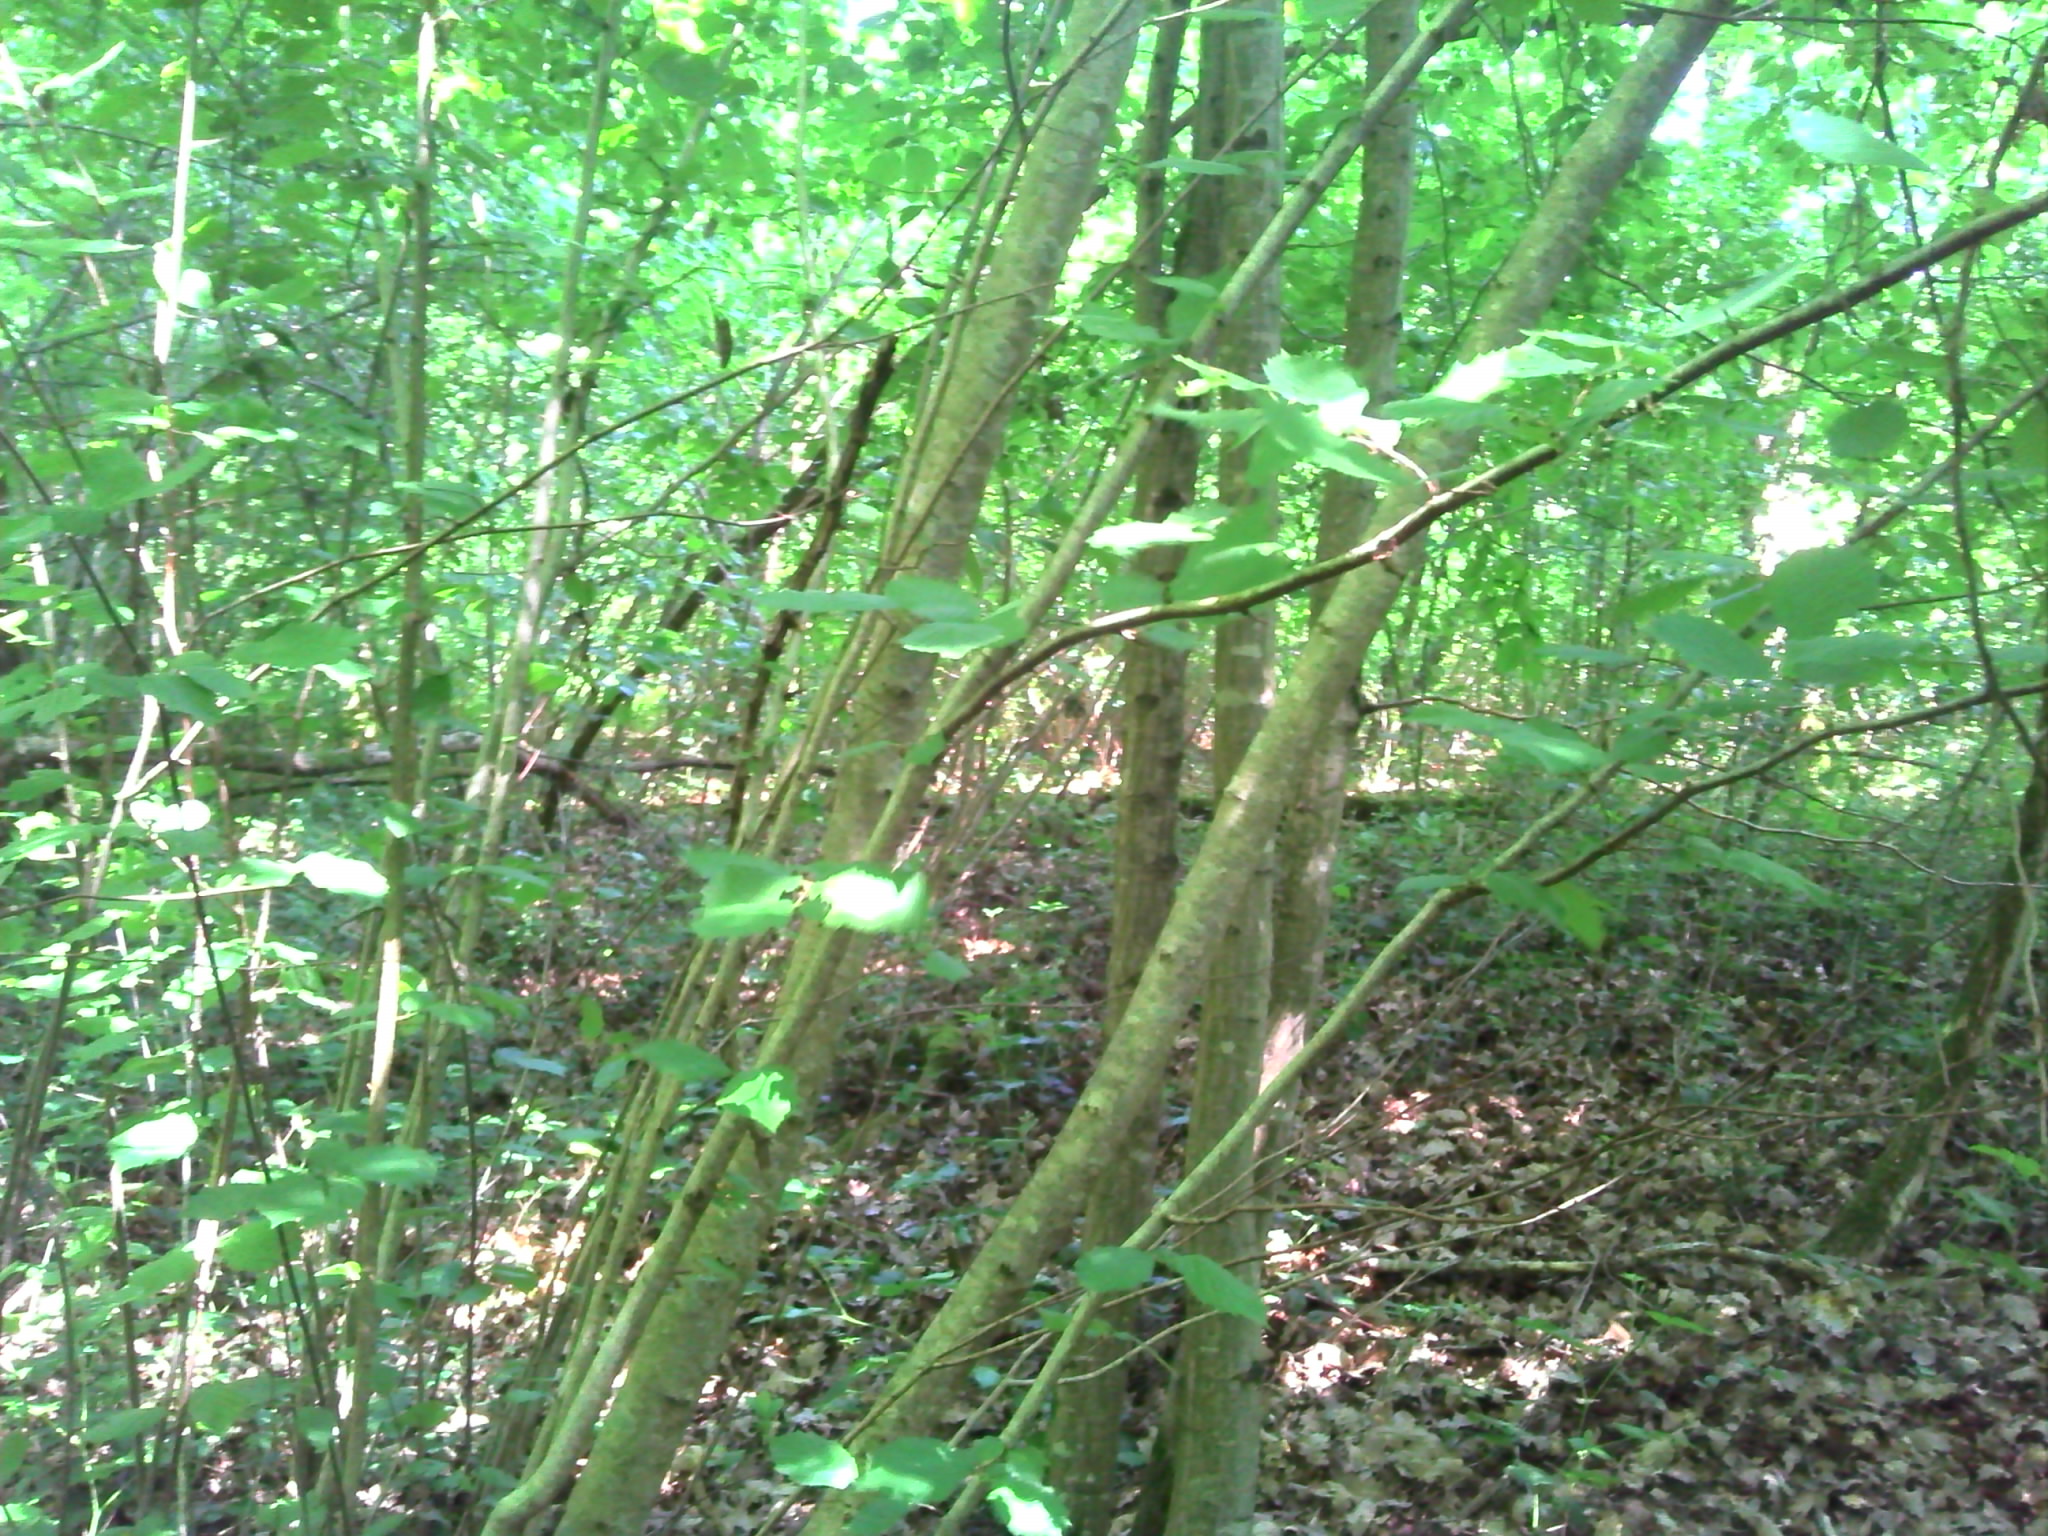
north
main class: Woodland
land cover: Broadleaved woodland
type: mesophytic deciduous forest
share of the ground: > 75 %
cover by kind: broadleaved forest trees 90 %, herbaceous plants 10 %
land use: Forestry
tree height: > 5 m
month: May
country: FR
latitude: 46.4993
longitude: 5.2725
